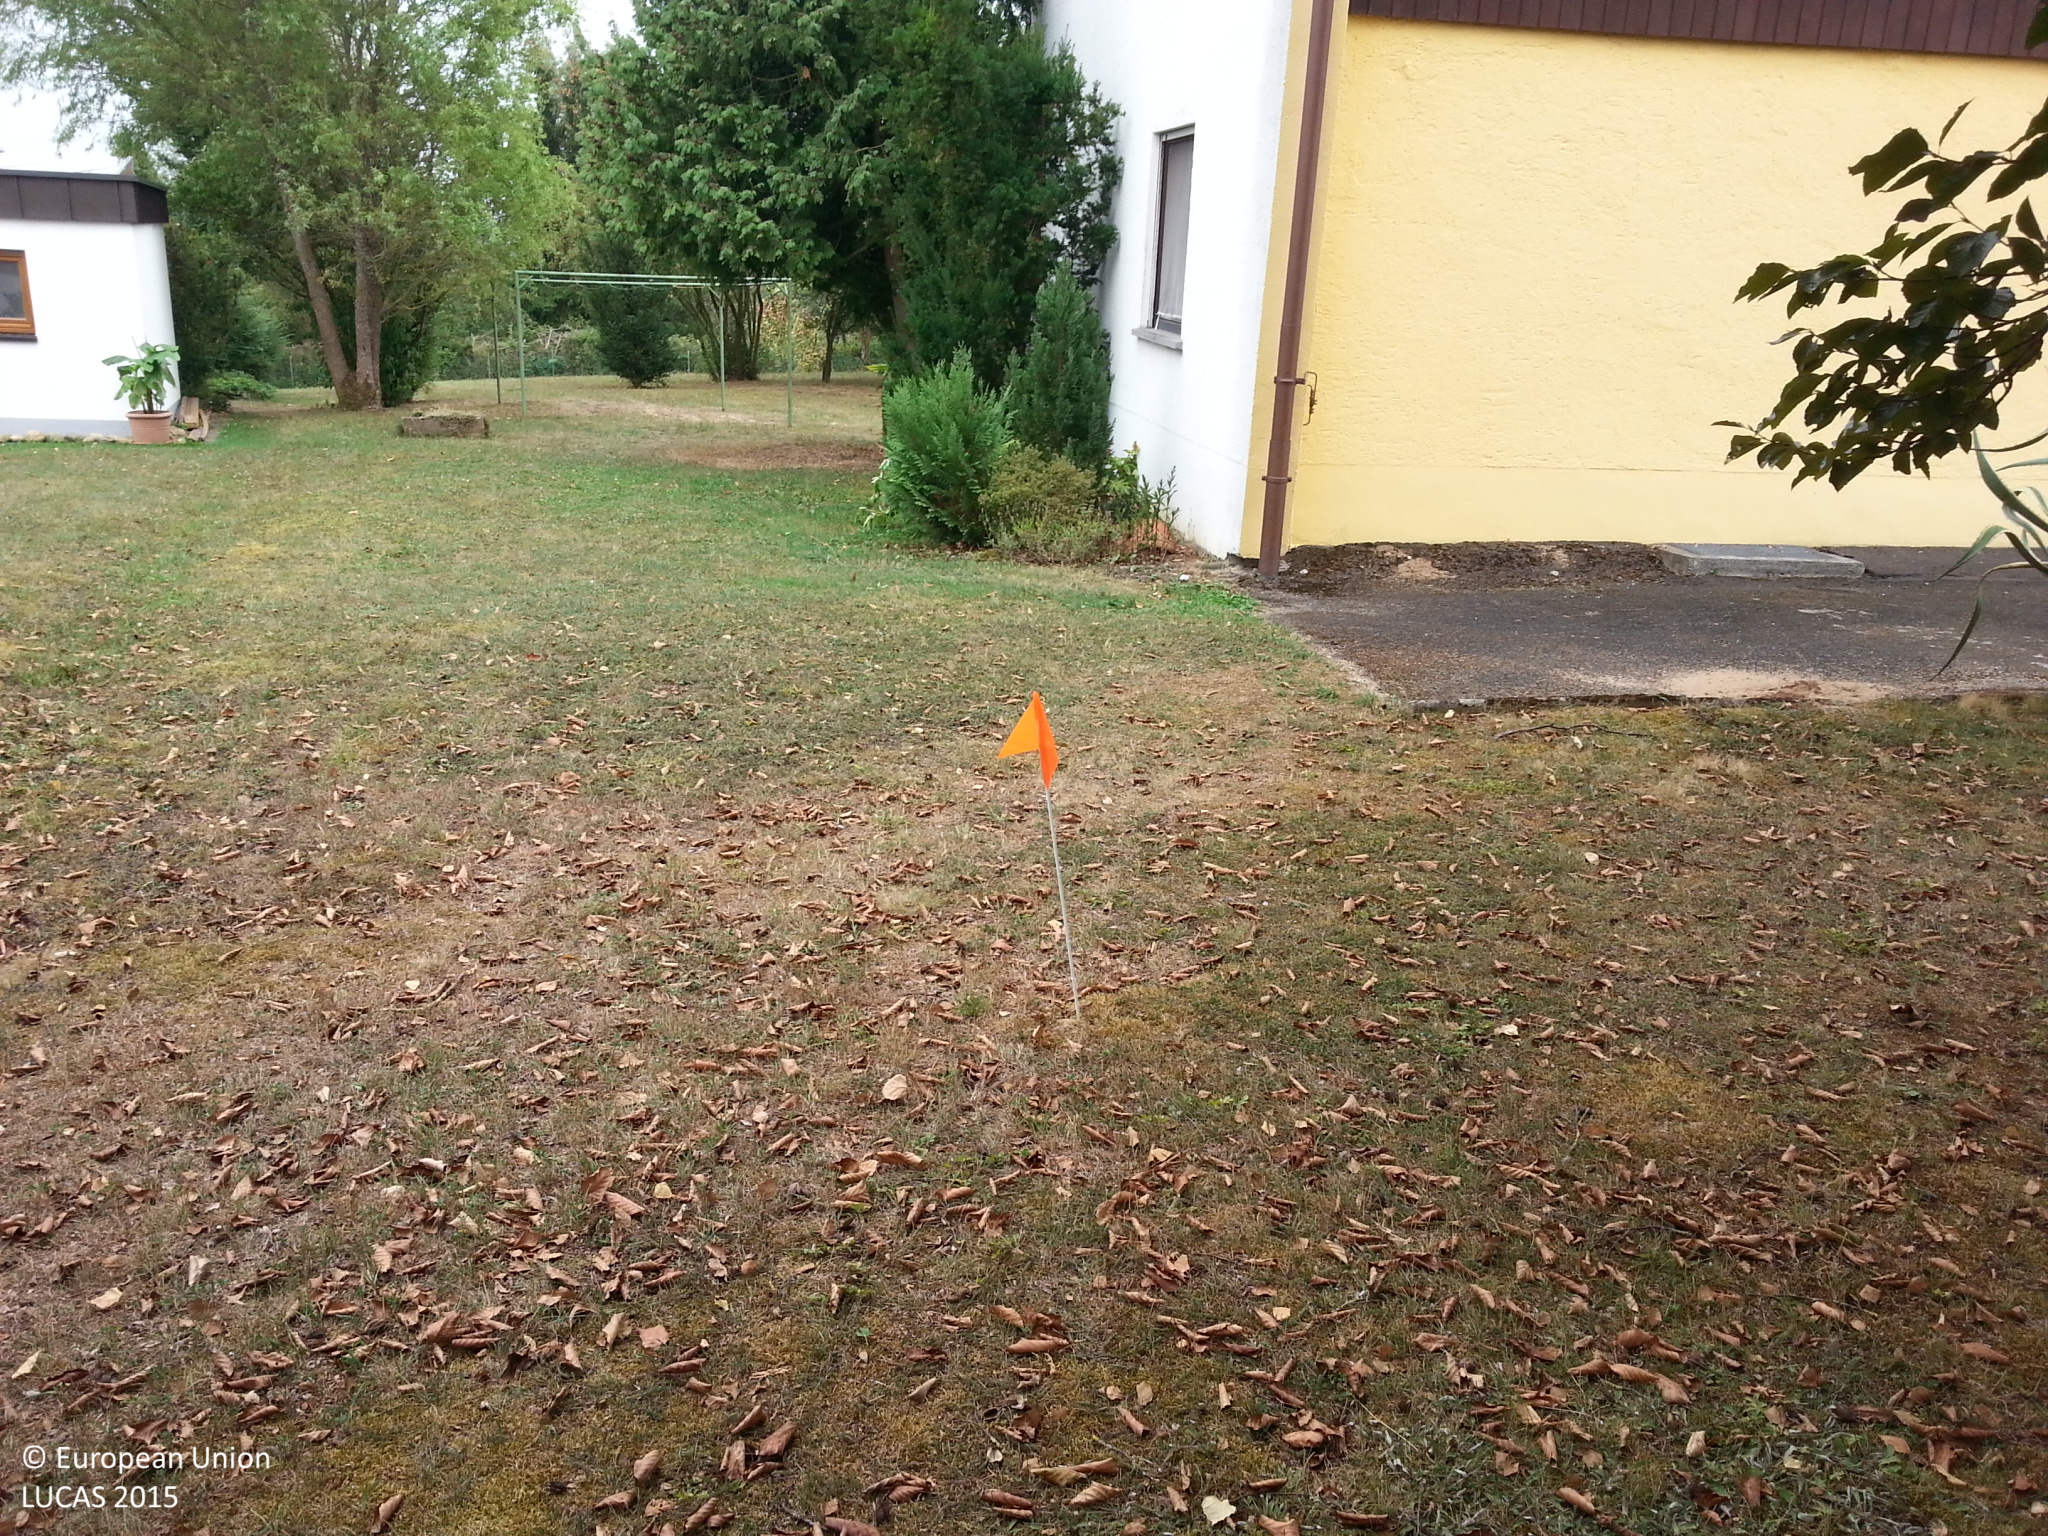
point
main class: Woodland
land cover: Broadleaved woodland
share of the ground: 50 - 75 %
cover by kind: broadleaved forest trees 70 %, herbaceous plants 30 %
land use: Residential
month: September
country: DE
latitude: 49.2490
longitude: 9.9313
